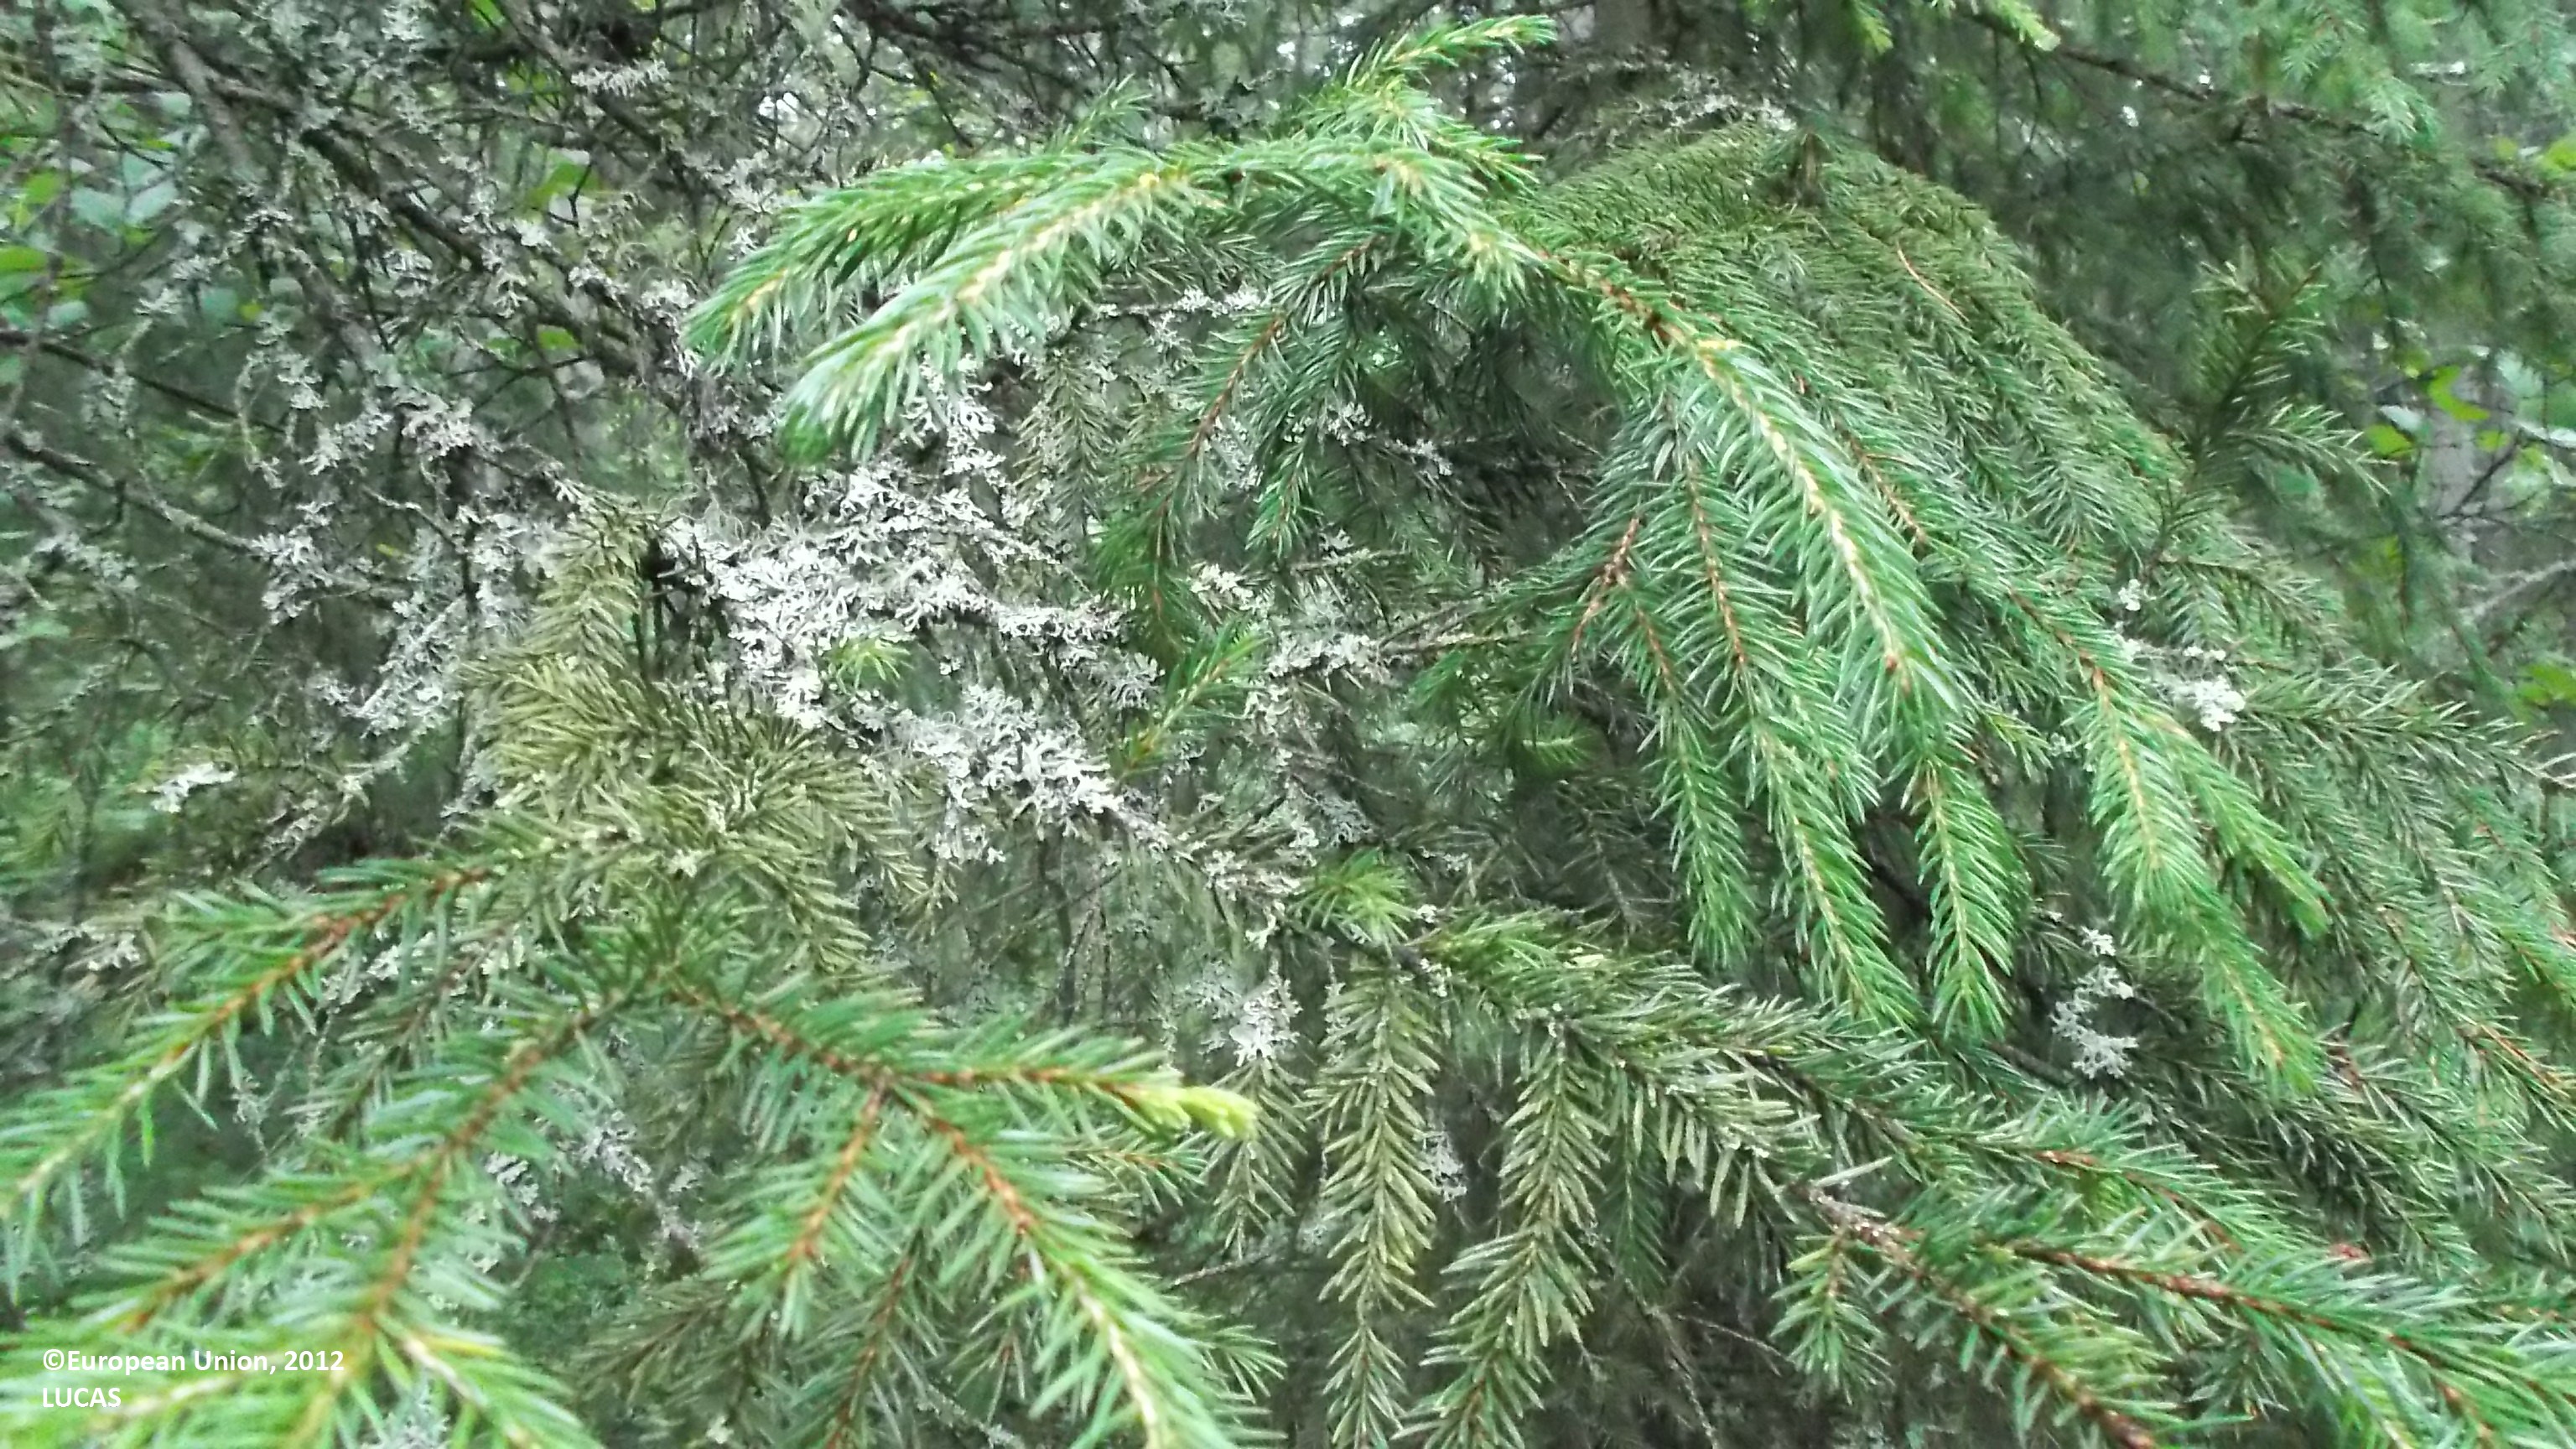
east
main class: Woodland
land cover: Spruce dominated mixed woodland
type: boreal forest
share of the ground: > 75 %
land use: Forestry
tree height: > 5 m
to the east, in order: Spruce dominated mixed woodland; Other mixed woodland; Spontaneously vegetated surfaces; Pine dominated mixed woodland; Tracks; Pine dominated mixed woodland
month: August
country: FI
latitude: 63.7657
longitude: 23.2554
